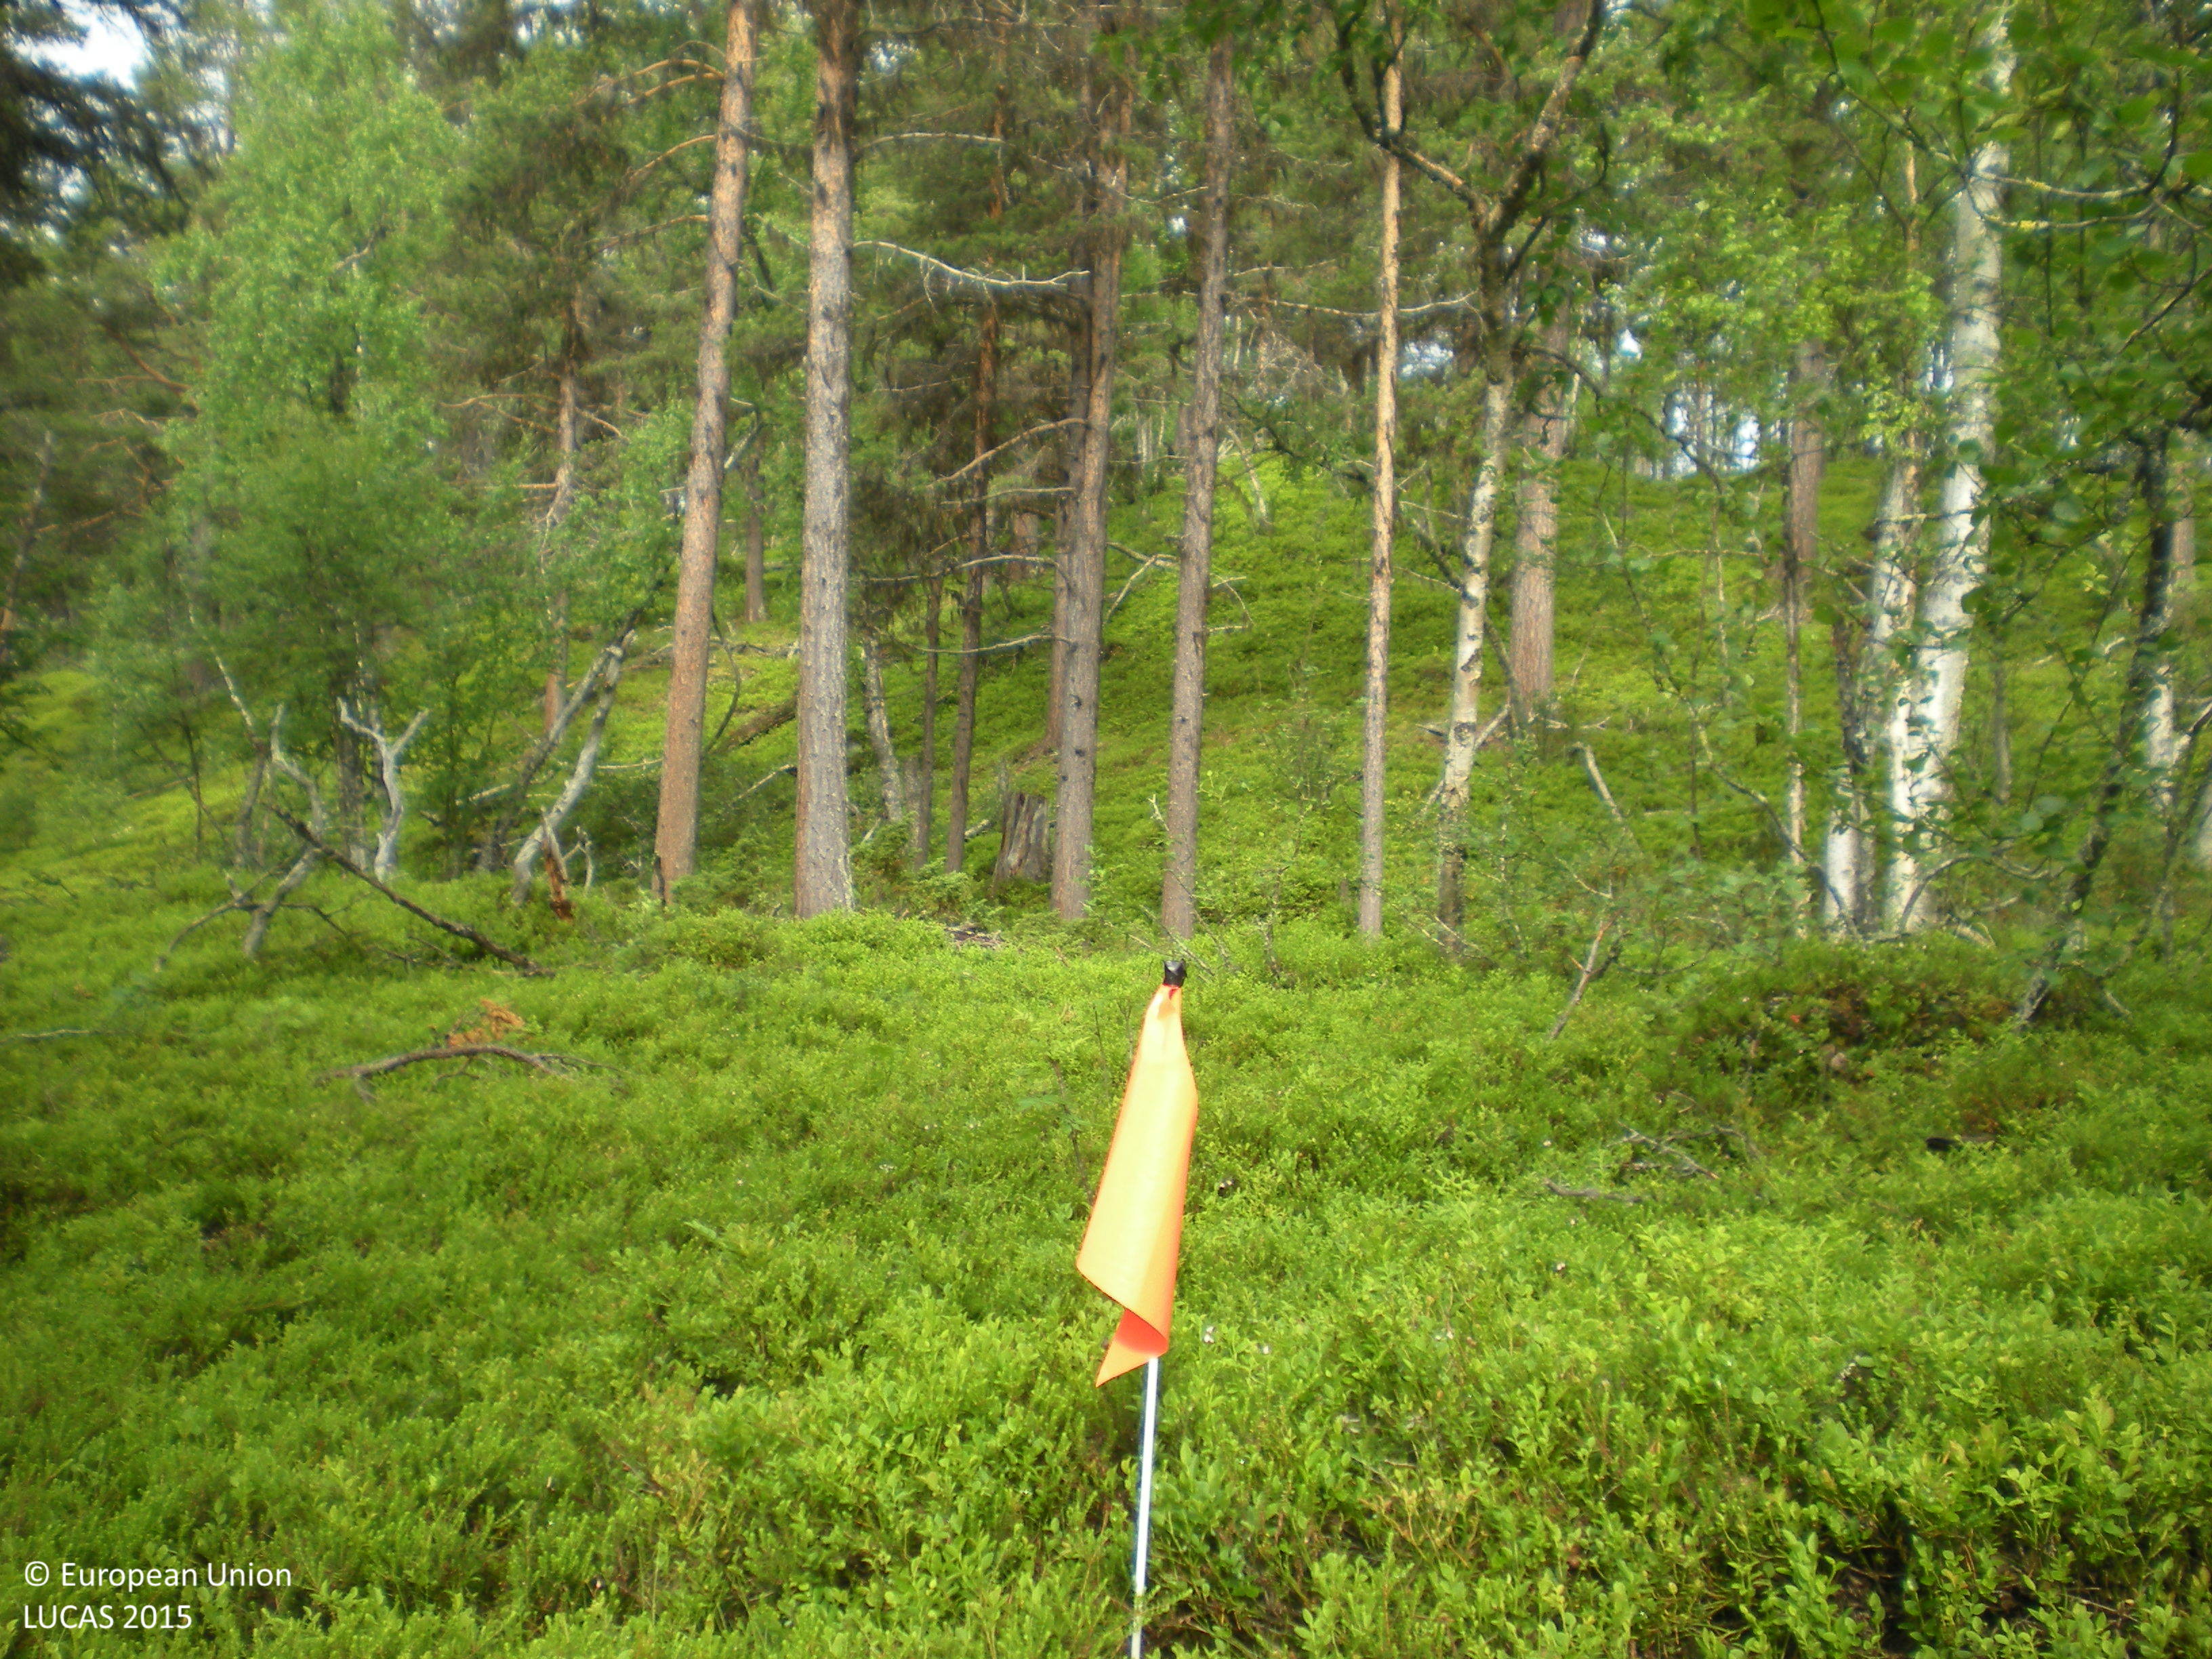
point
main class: Woodland
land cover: Pine dominated mixed woodland
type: boreal forest
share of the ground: 50 - 75 %
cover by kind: coniferous forest trees 45 %, shrubs 25 %, broadleaved forest trees 20 %, lichens and mosses 10 %
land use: Semi-natural and natural areas not in use
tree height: > 5 m
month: August
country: SE
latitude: 66.4273
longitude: 16.8782
